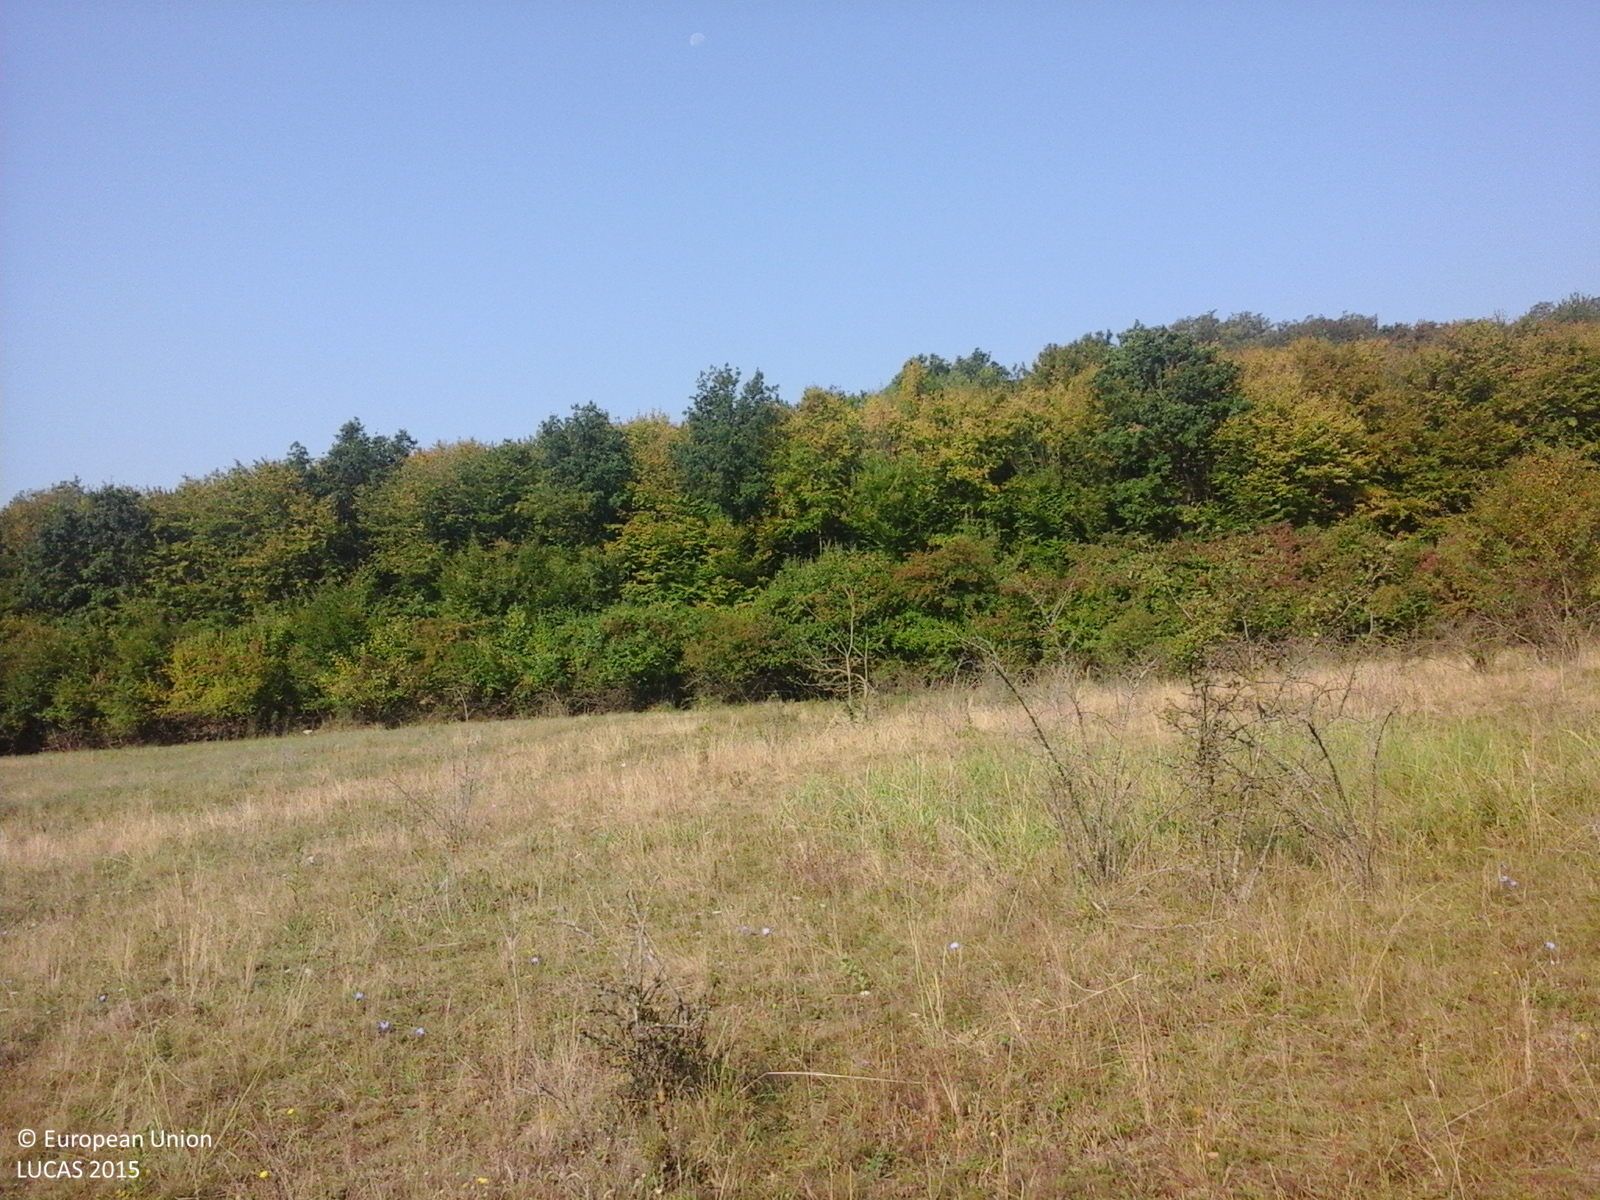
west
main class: Grassland
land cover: Grassland with sparse tree/shrub cover
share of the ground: > 75 %
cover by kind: herbaceous plants 95 %, broadleaved forest trees 5 %
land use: Fallow land
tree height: < 5 m
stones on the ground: < 10 %
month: September
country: RO
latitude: 47.1935
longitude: 24.3024
